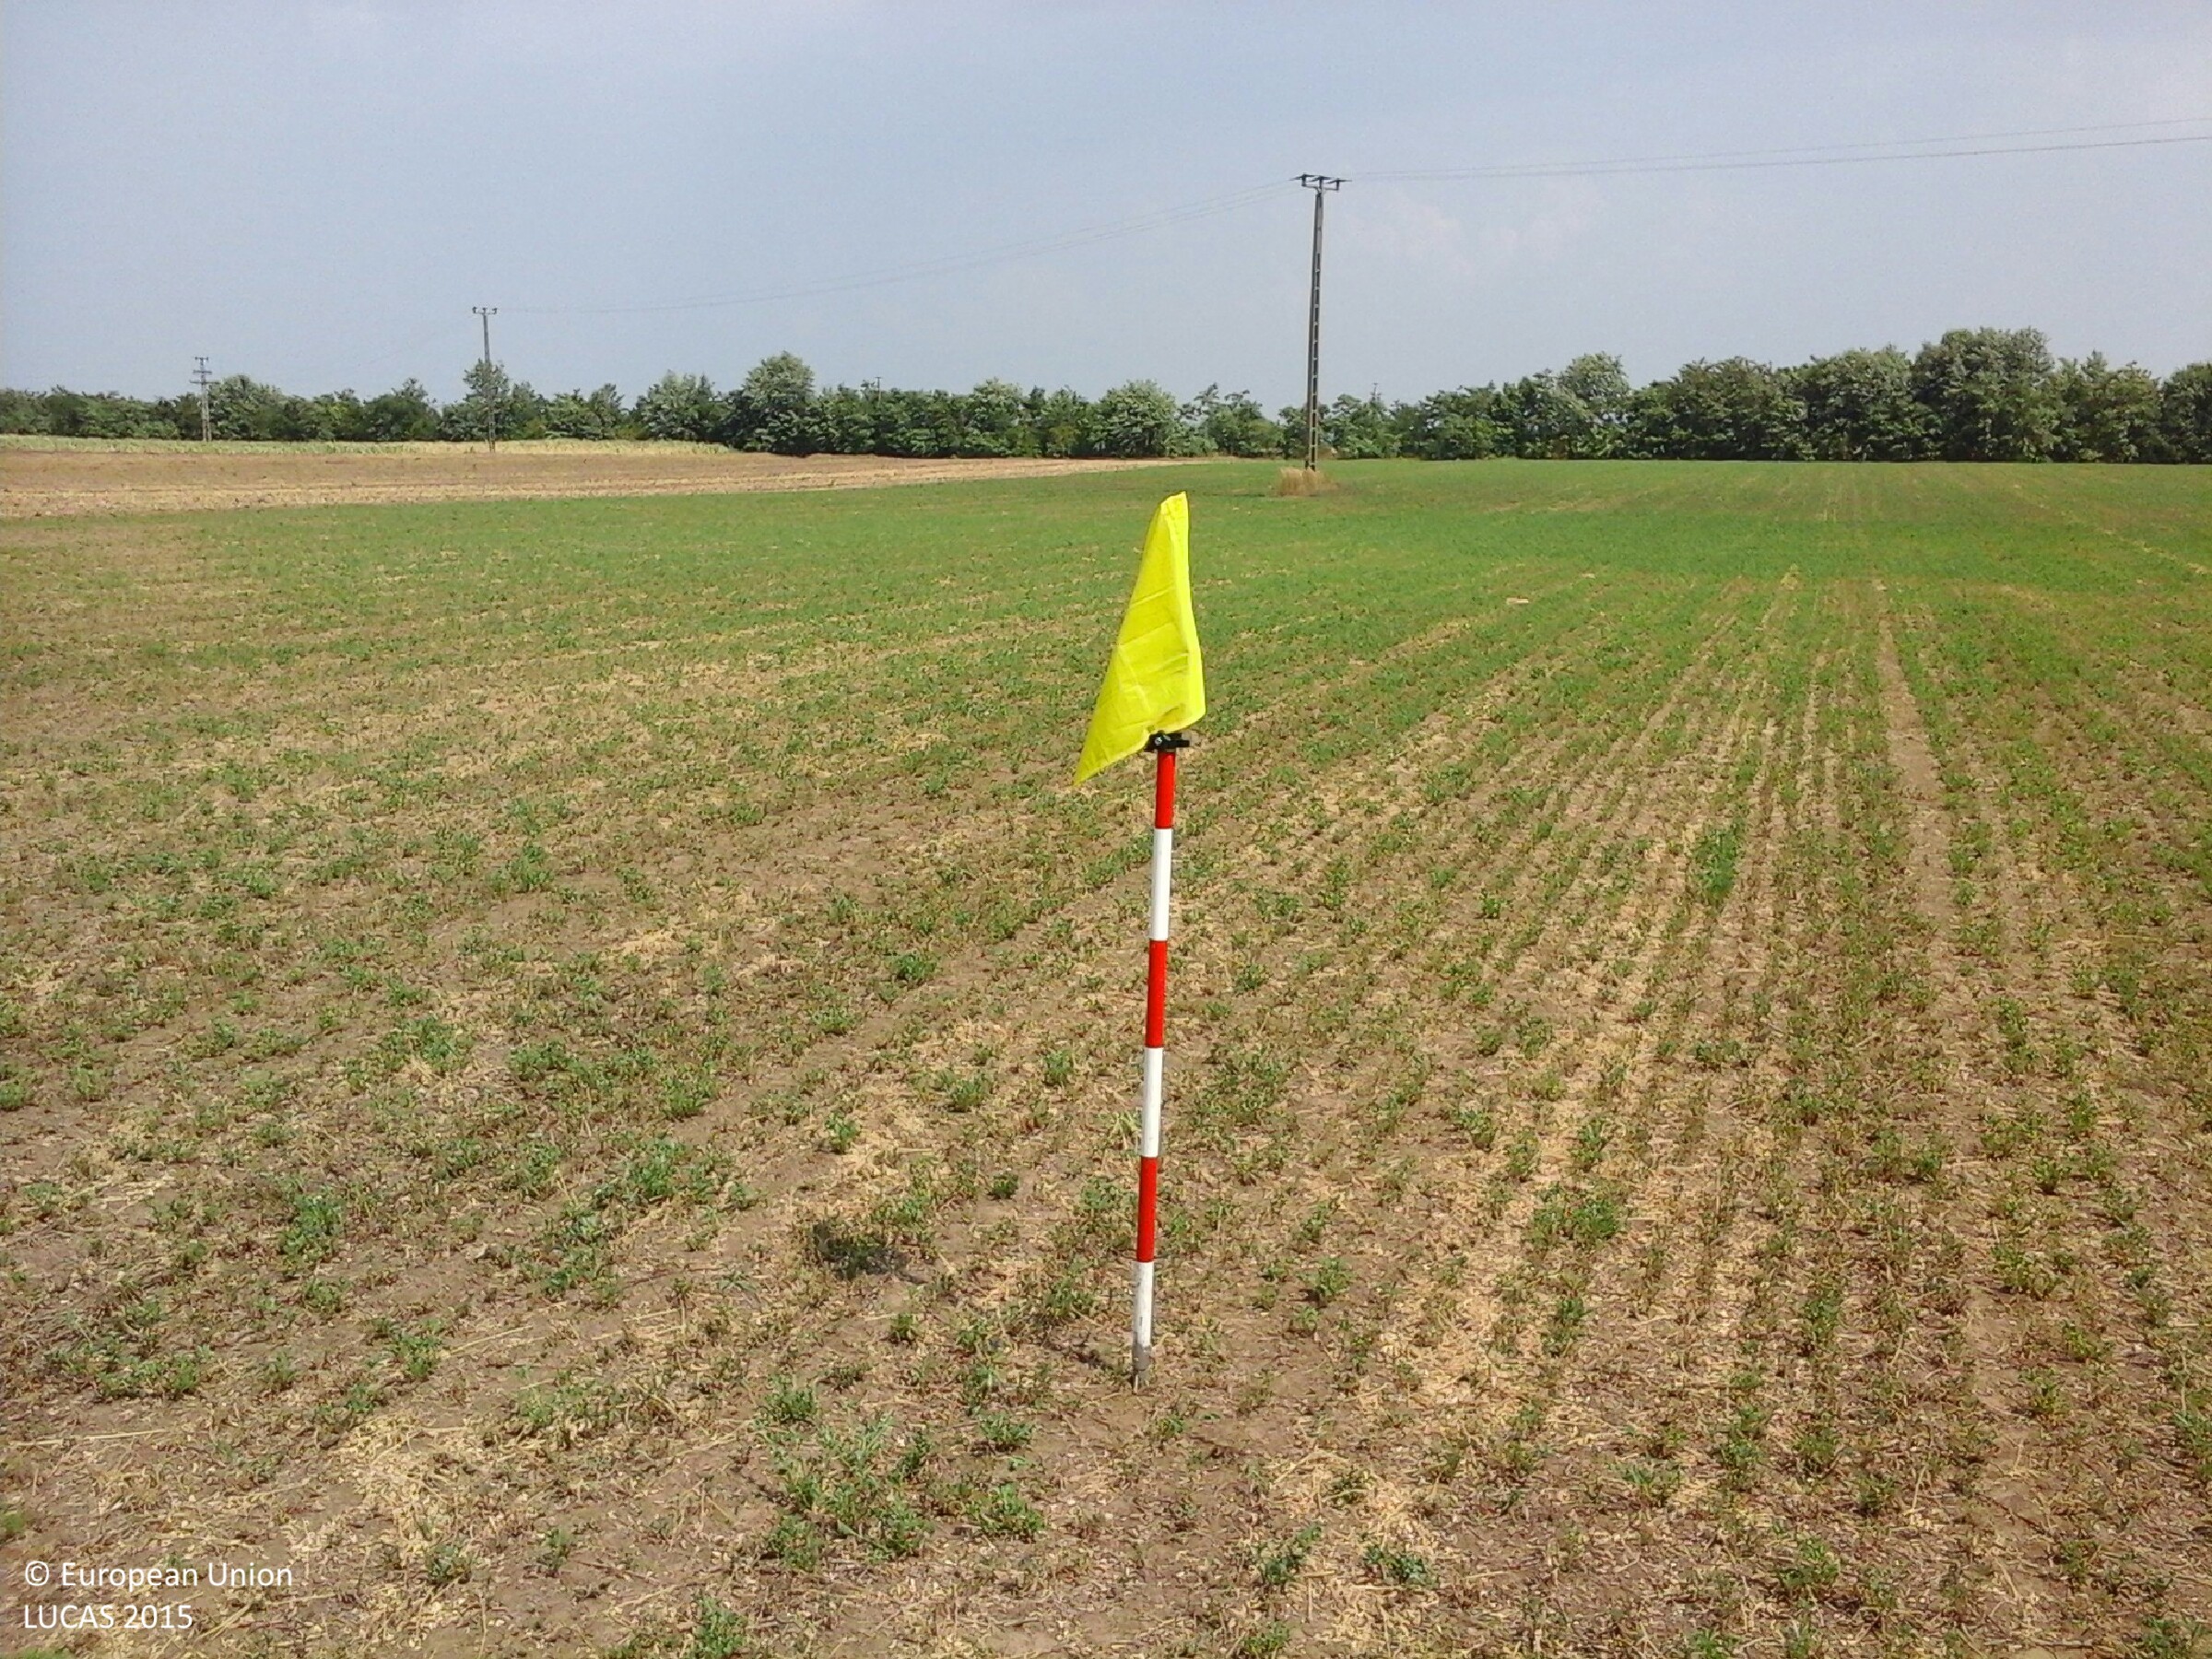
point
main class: Cropland
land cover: Lucerne
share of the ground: 50 - 75 %
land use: Agriculture (excluding fallow land and kitchen gardens)
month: July
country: HU
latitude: 47.8012
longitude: 20.9725
